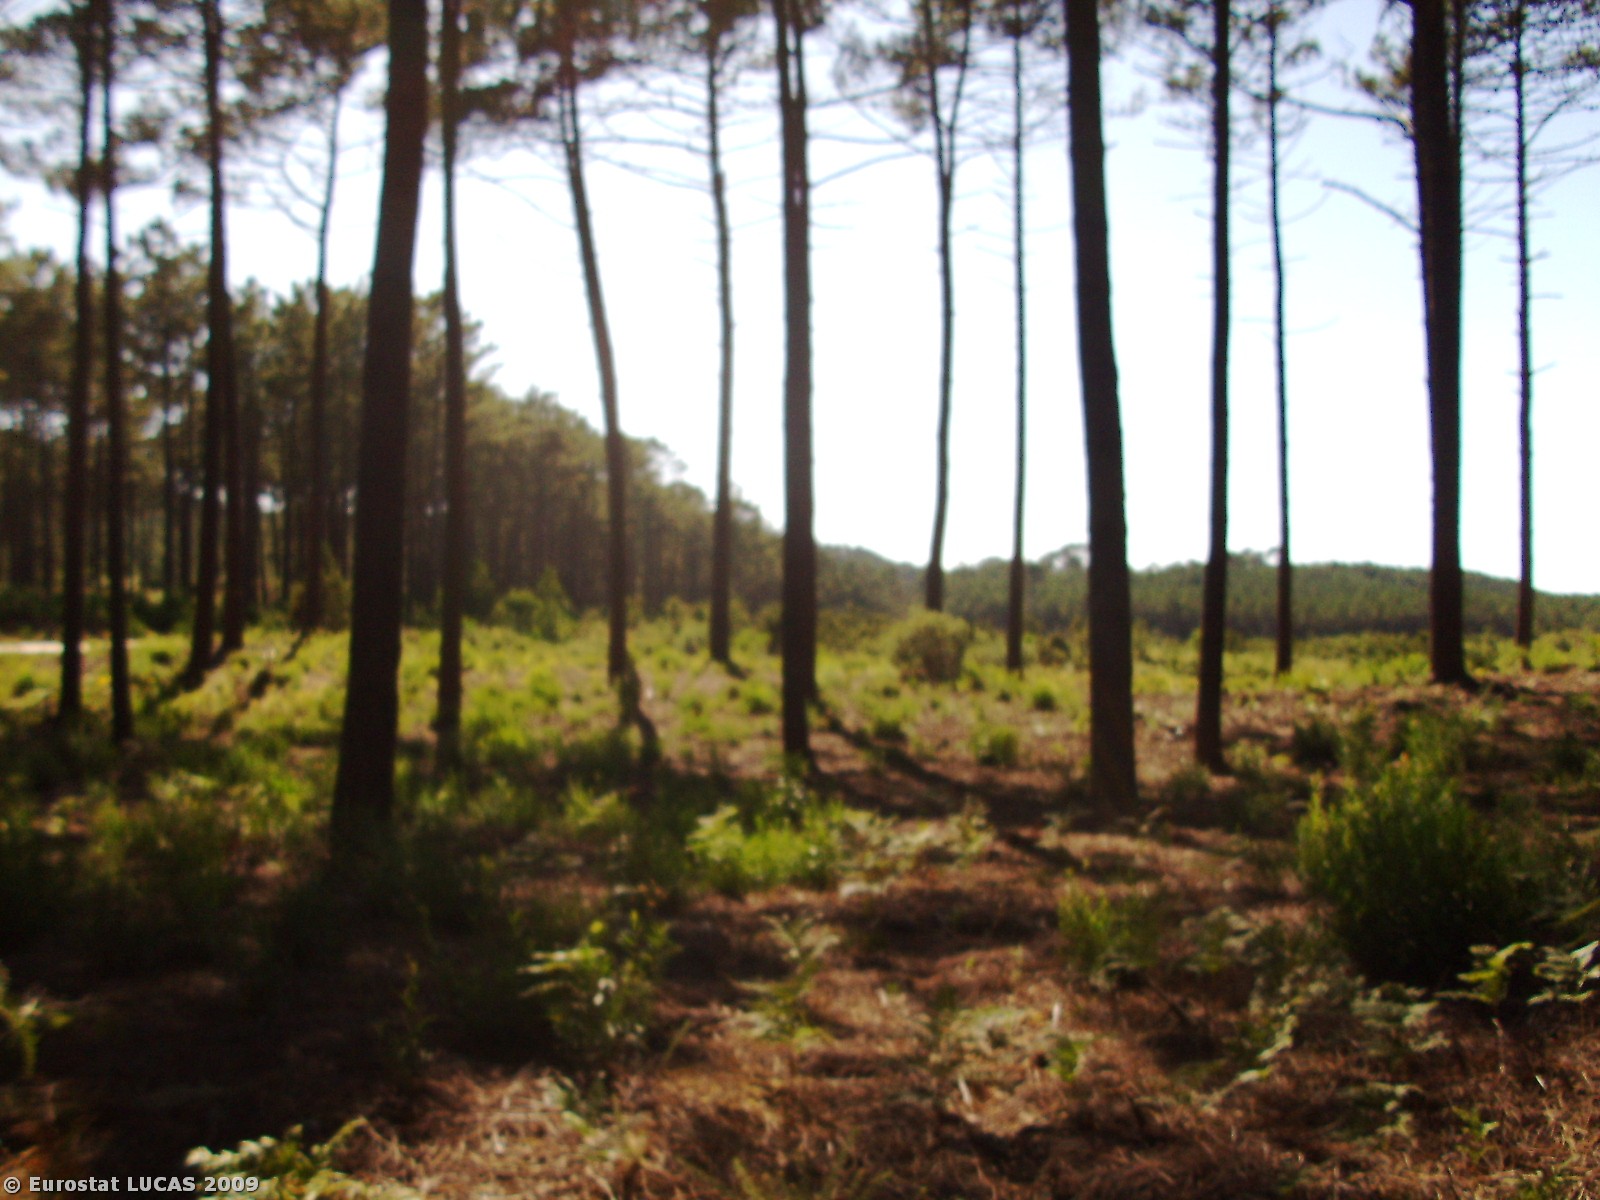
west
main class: Woodland
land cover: Coniferous woodland
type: coniferous forest of the mediterranean region
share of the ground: > 75 %
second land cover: Shrubland with sparse tree cover
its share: 10 - 25 %
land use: Forestry
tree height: > 5 m
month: July
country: PT
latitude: 39.7639
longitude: -8.9905
